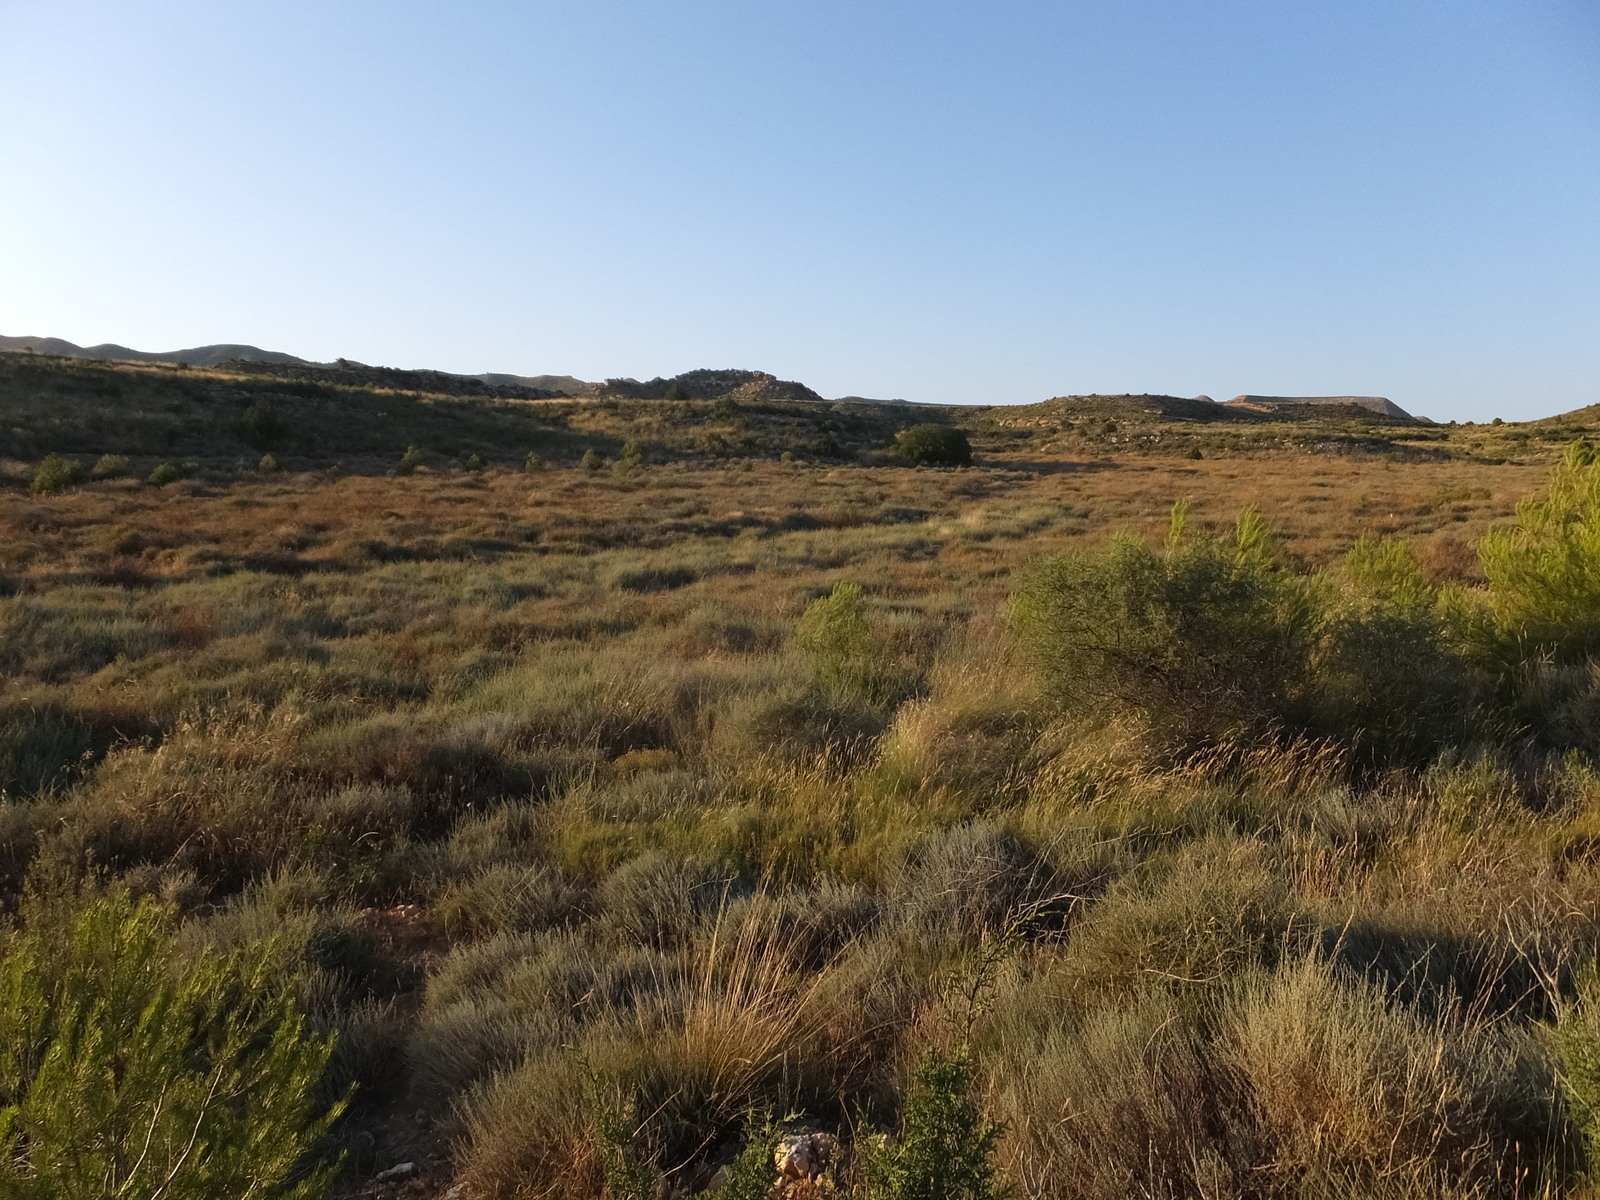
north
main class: Shrubland
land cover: Shrubland with sparse tree cover
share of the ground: > 75 %
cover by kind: shrubs 75 %, herbaceous plants 20 %, coniferous forest trees 5 %
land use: Semi-natural and natural areas not in use
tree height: < 5 m
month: June
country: ES
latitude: 41.3087
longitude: -0.2988
